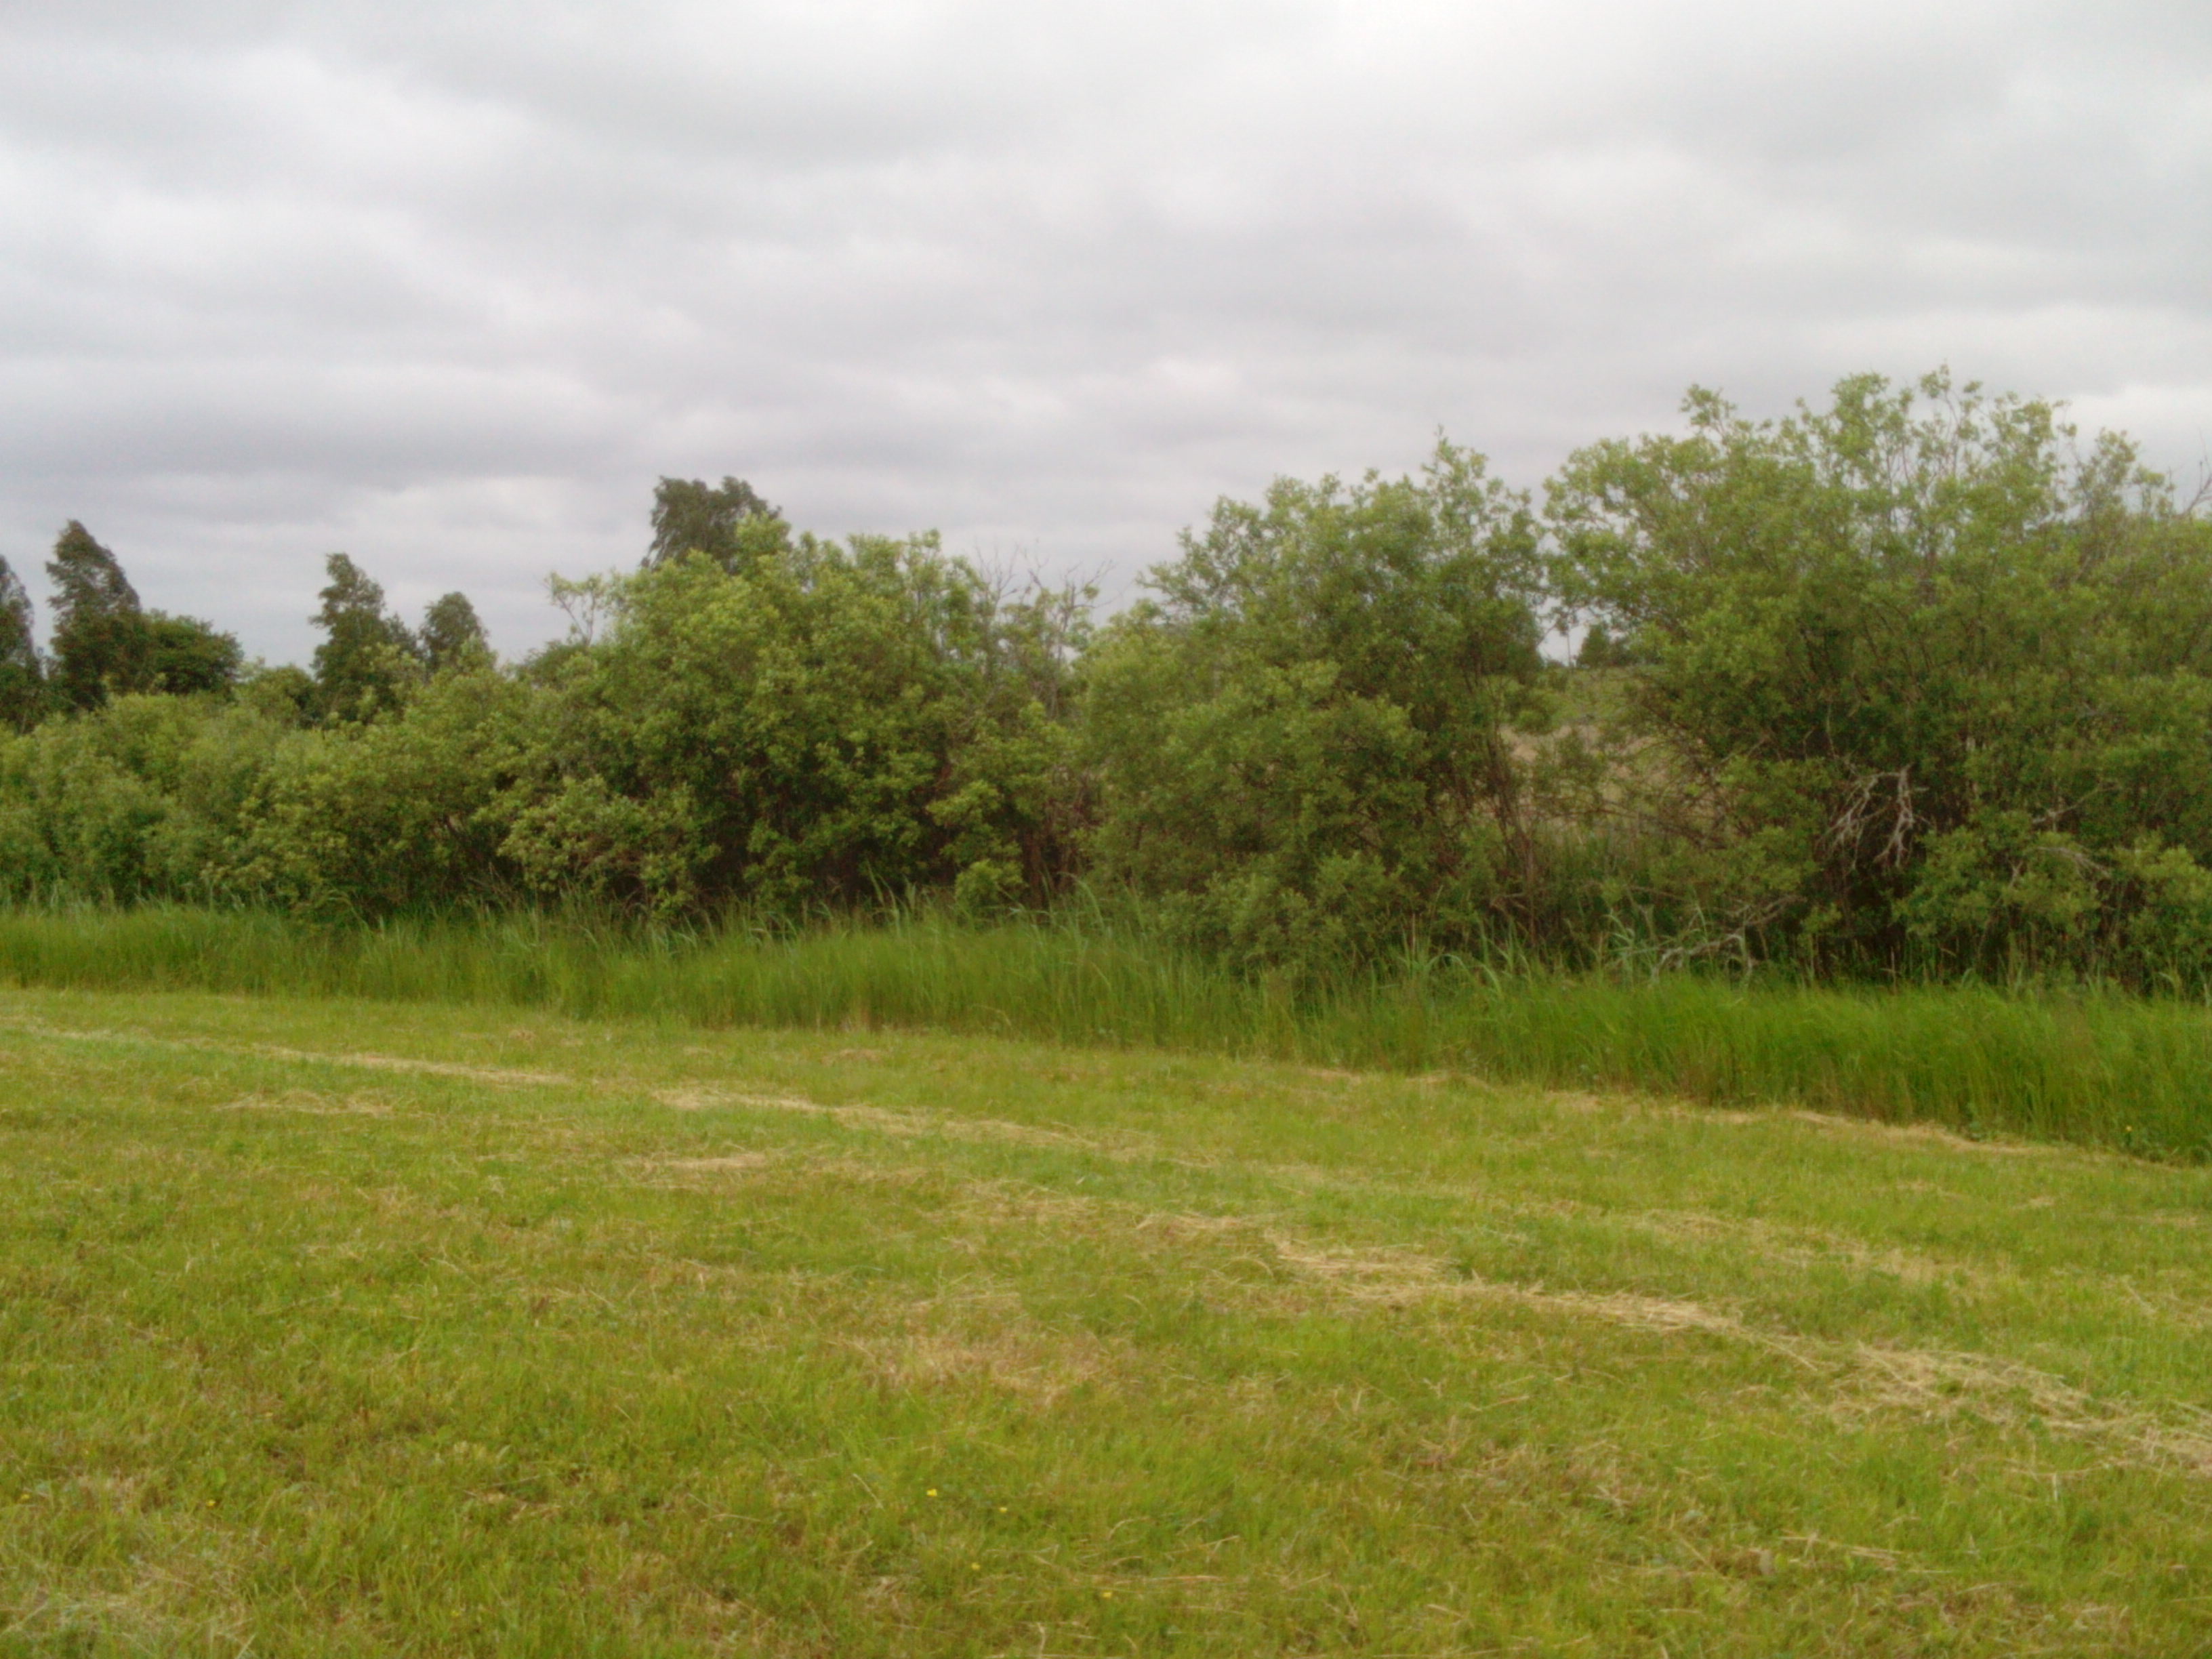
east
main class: Grassland
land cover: Grassland without tree/shrub cover
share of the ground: > 75 %
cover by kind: herbaceous plants 100 %
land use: Agriculture (excluding fallow land and kitchen gardens)
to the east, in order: Grassland without tree/shrub cover; Broadleaved woodland; Inland marshes; Inland salty water bodies; Broadleaved woodland; Grassland without tree/shrub cover; Tracks; Grassland without tree/shrub cover
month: June
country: LV
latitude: 56.8419
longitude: 21.9986
